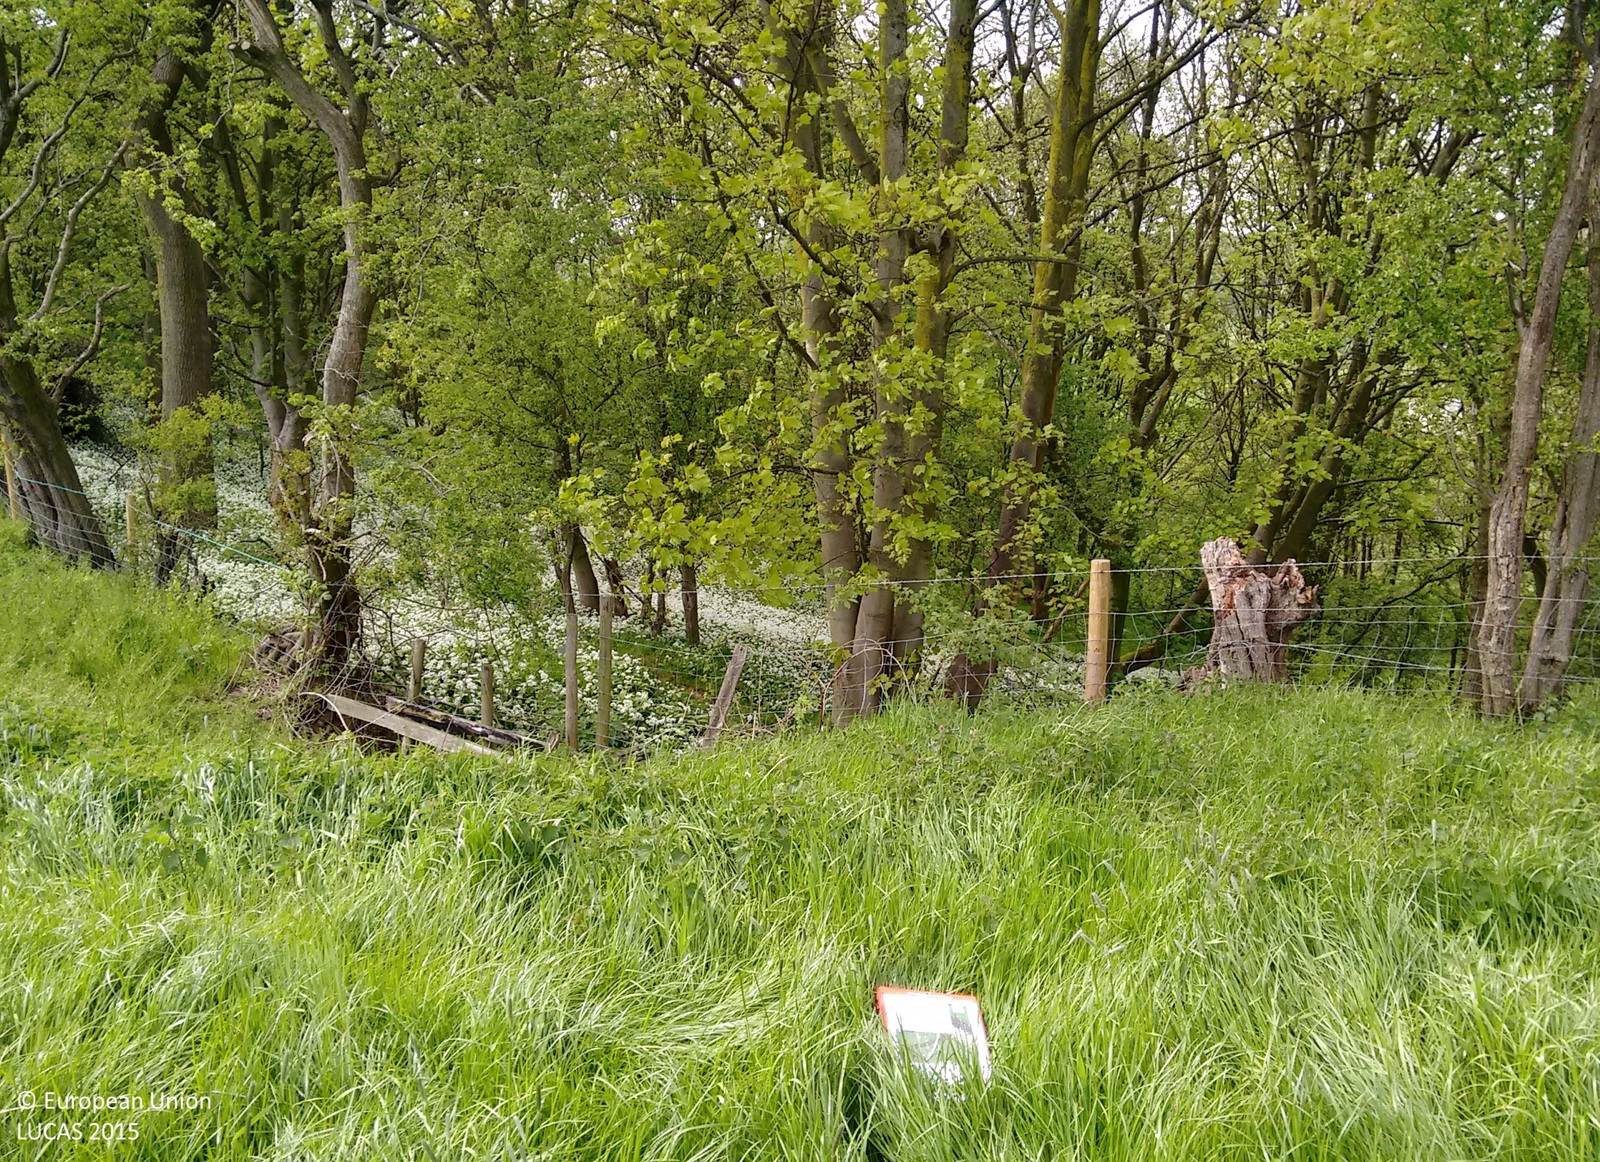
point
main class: Grassland
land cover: Grassland without tree/shrub cover
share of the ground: > 75 %
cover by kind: herbaceous plants 100 %
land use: Agriculture (excluding fallow land and kitchen gardens)
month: May
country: GB
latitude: 53.7559
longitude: -2.6409
